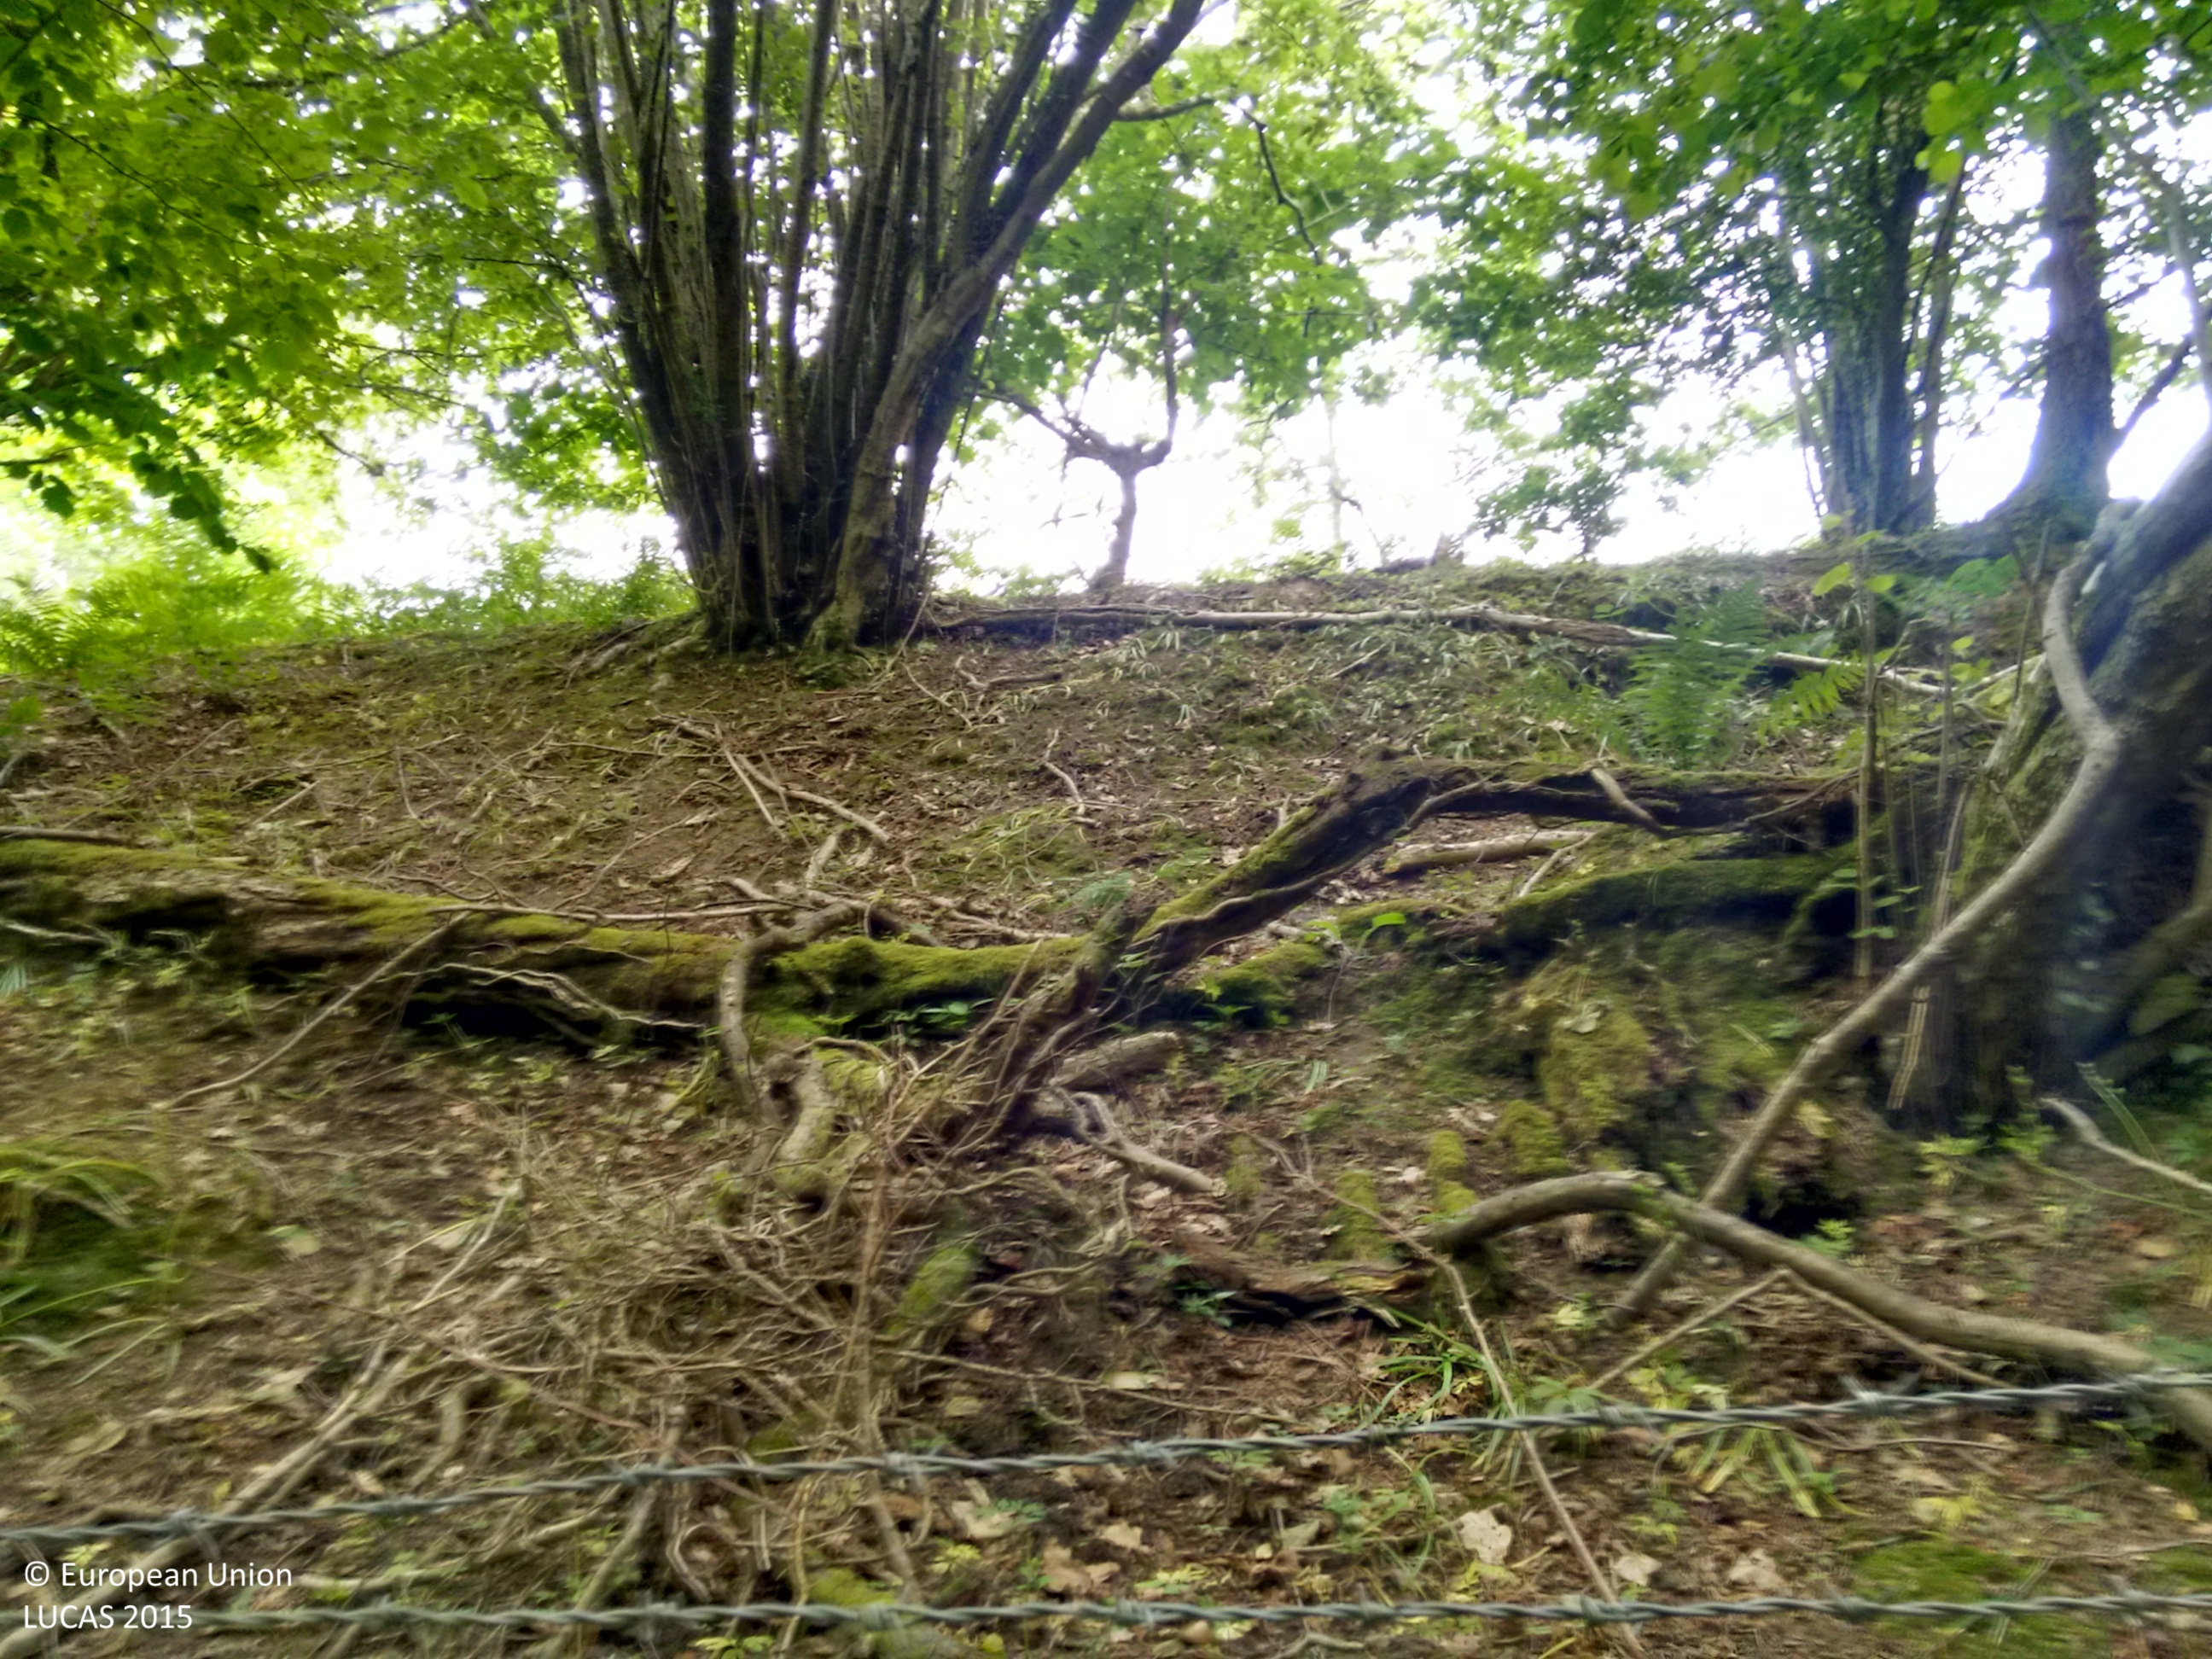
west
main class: Woodland
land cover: Broadleaved woodland
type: mesophytic deciduous forest
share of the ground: > 75 %
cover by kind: broadleaved forest trees 90 %, shrubs 10 %
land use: Forestry
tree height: > 5 m
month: June
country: GB
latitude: 50.9913
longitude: 0.1814
